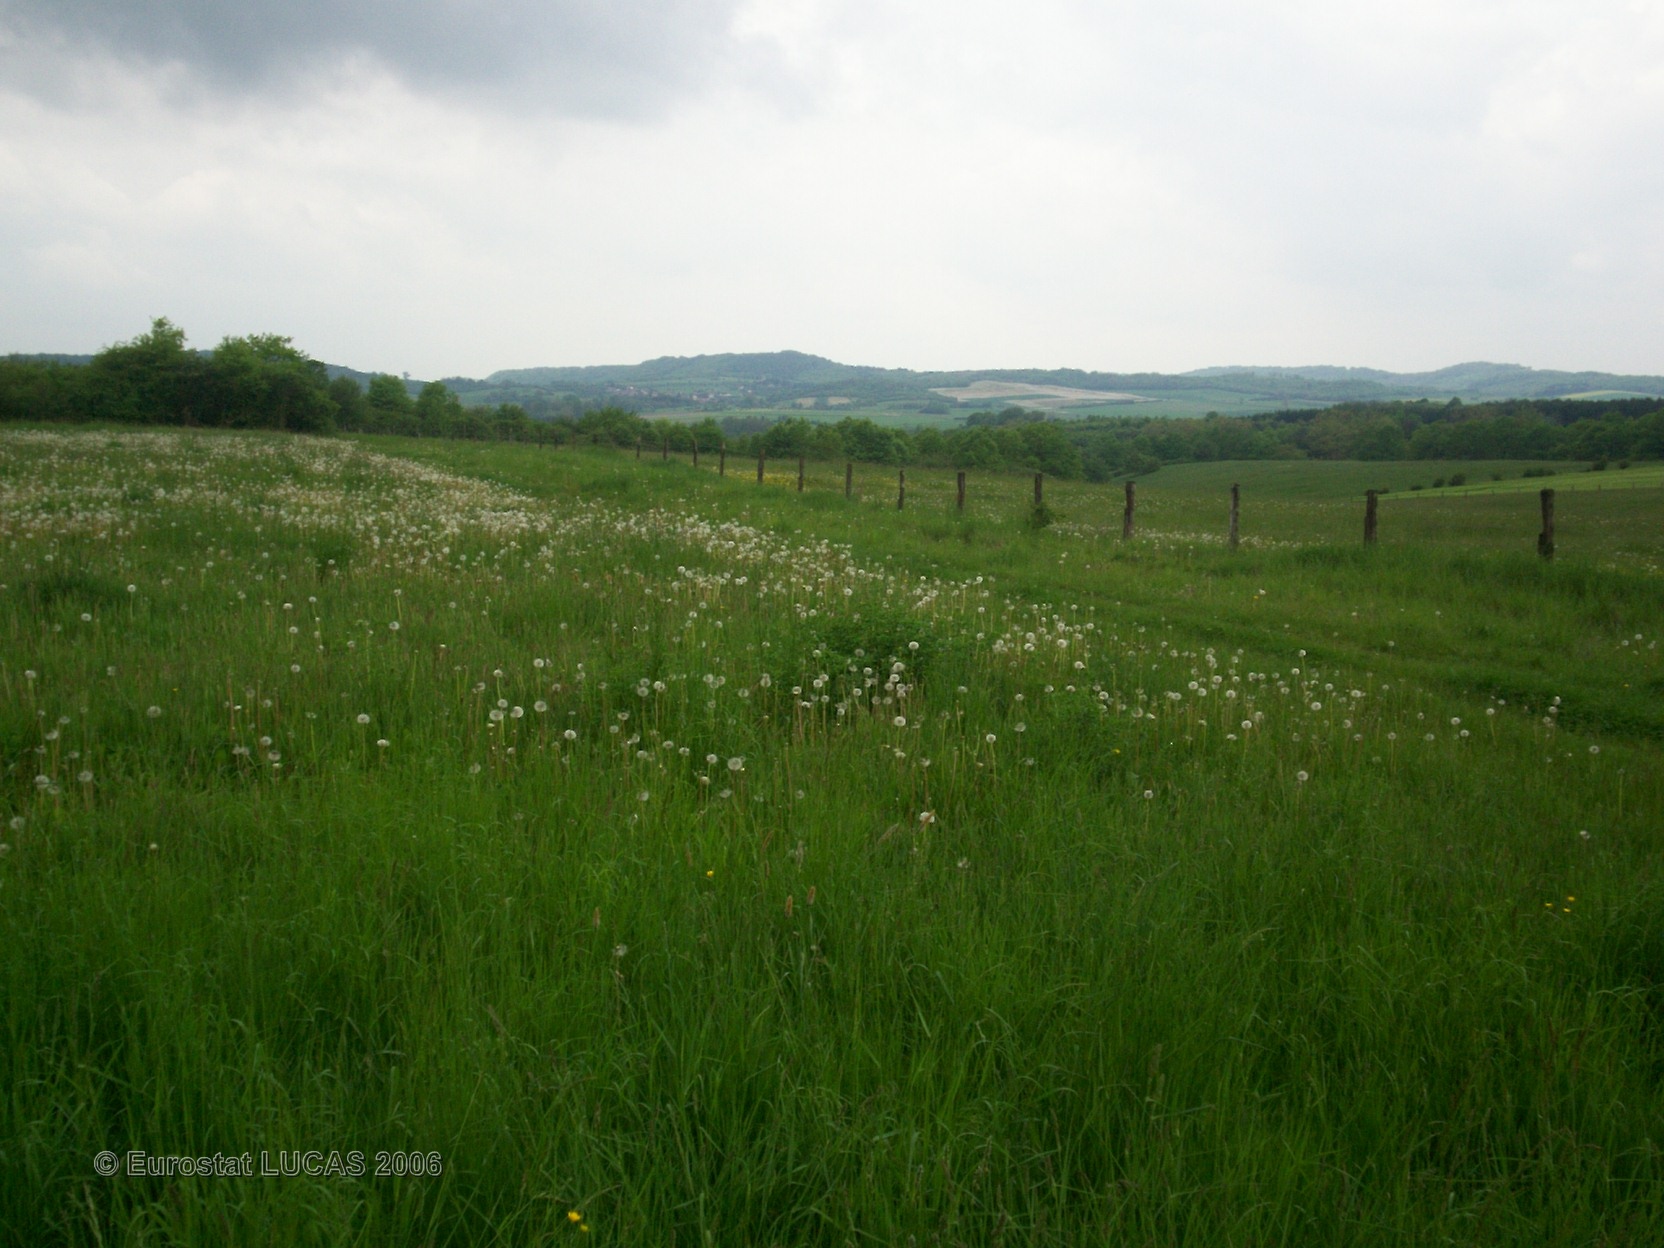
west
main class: Grassland
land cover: Grassland without tree/shrub cover
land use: Agriculture (excluding fallow land and kitchen gardens)
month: May
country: FR
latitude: 49.3365
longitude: 6.4355
